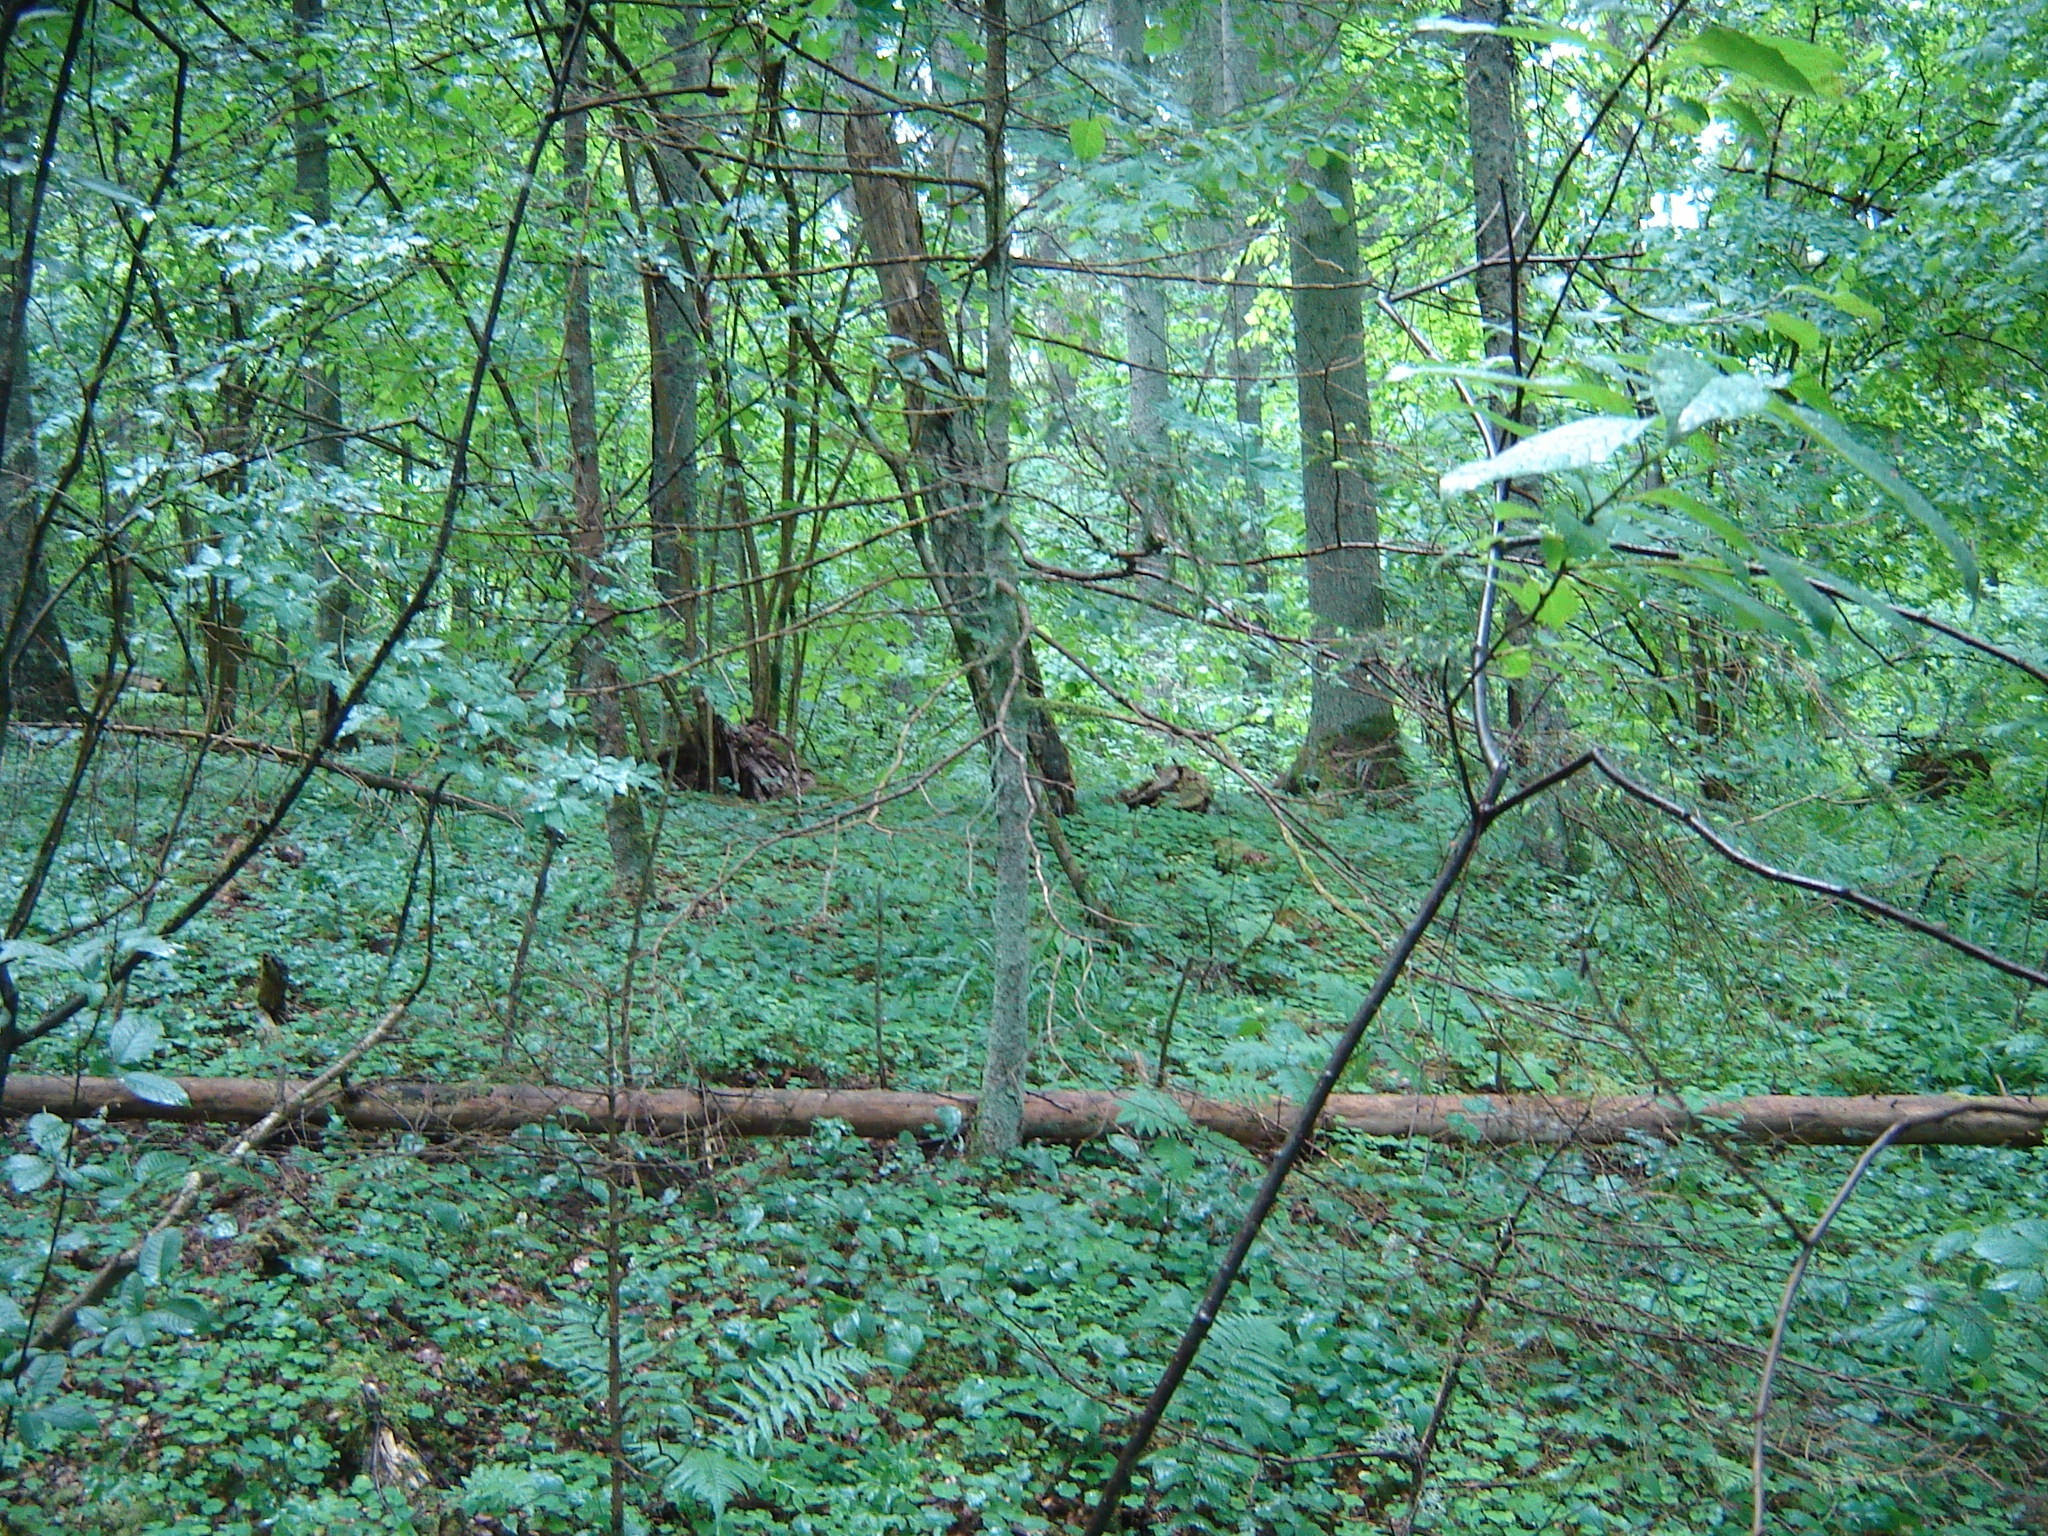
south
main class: Woodland
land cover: Spruce dominated coniferous woodland
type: hemiboreal forest and nemoral coniferous forest and mixed broadleaved-coniferous forest
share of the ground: > 75 %
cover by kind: coniferous forest trees 90 %, broadleaved forest trees 10 %
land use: Forestry
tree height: > 5 m
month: June
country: LT
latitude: 55.6594
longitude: 25.2006
